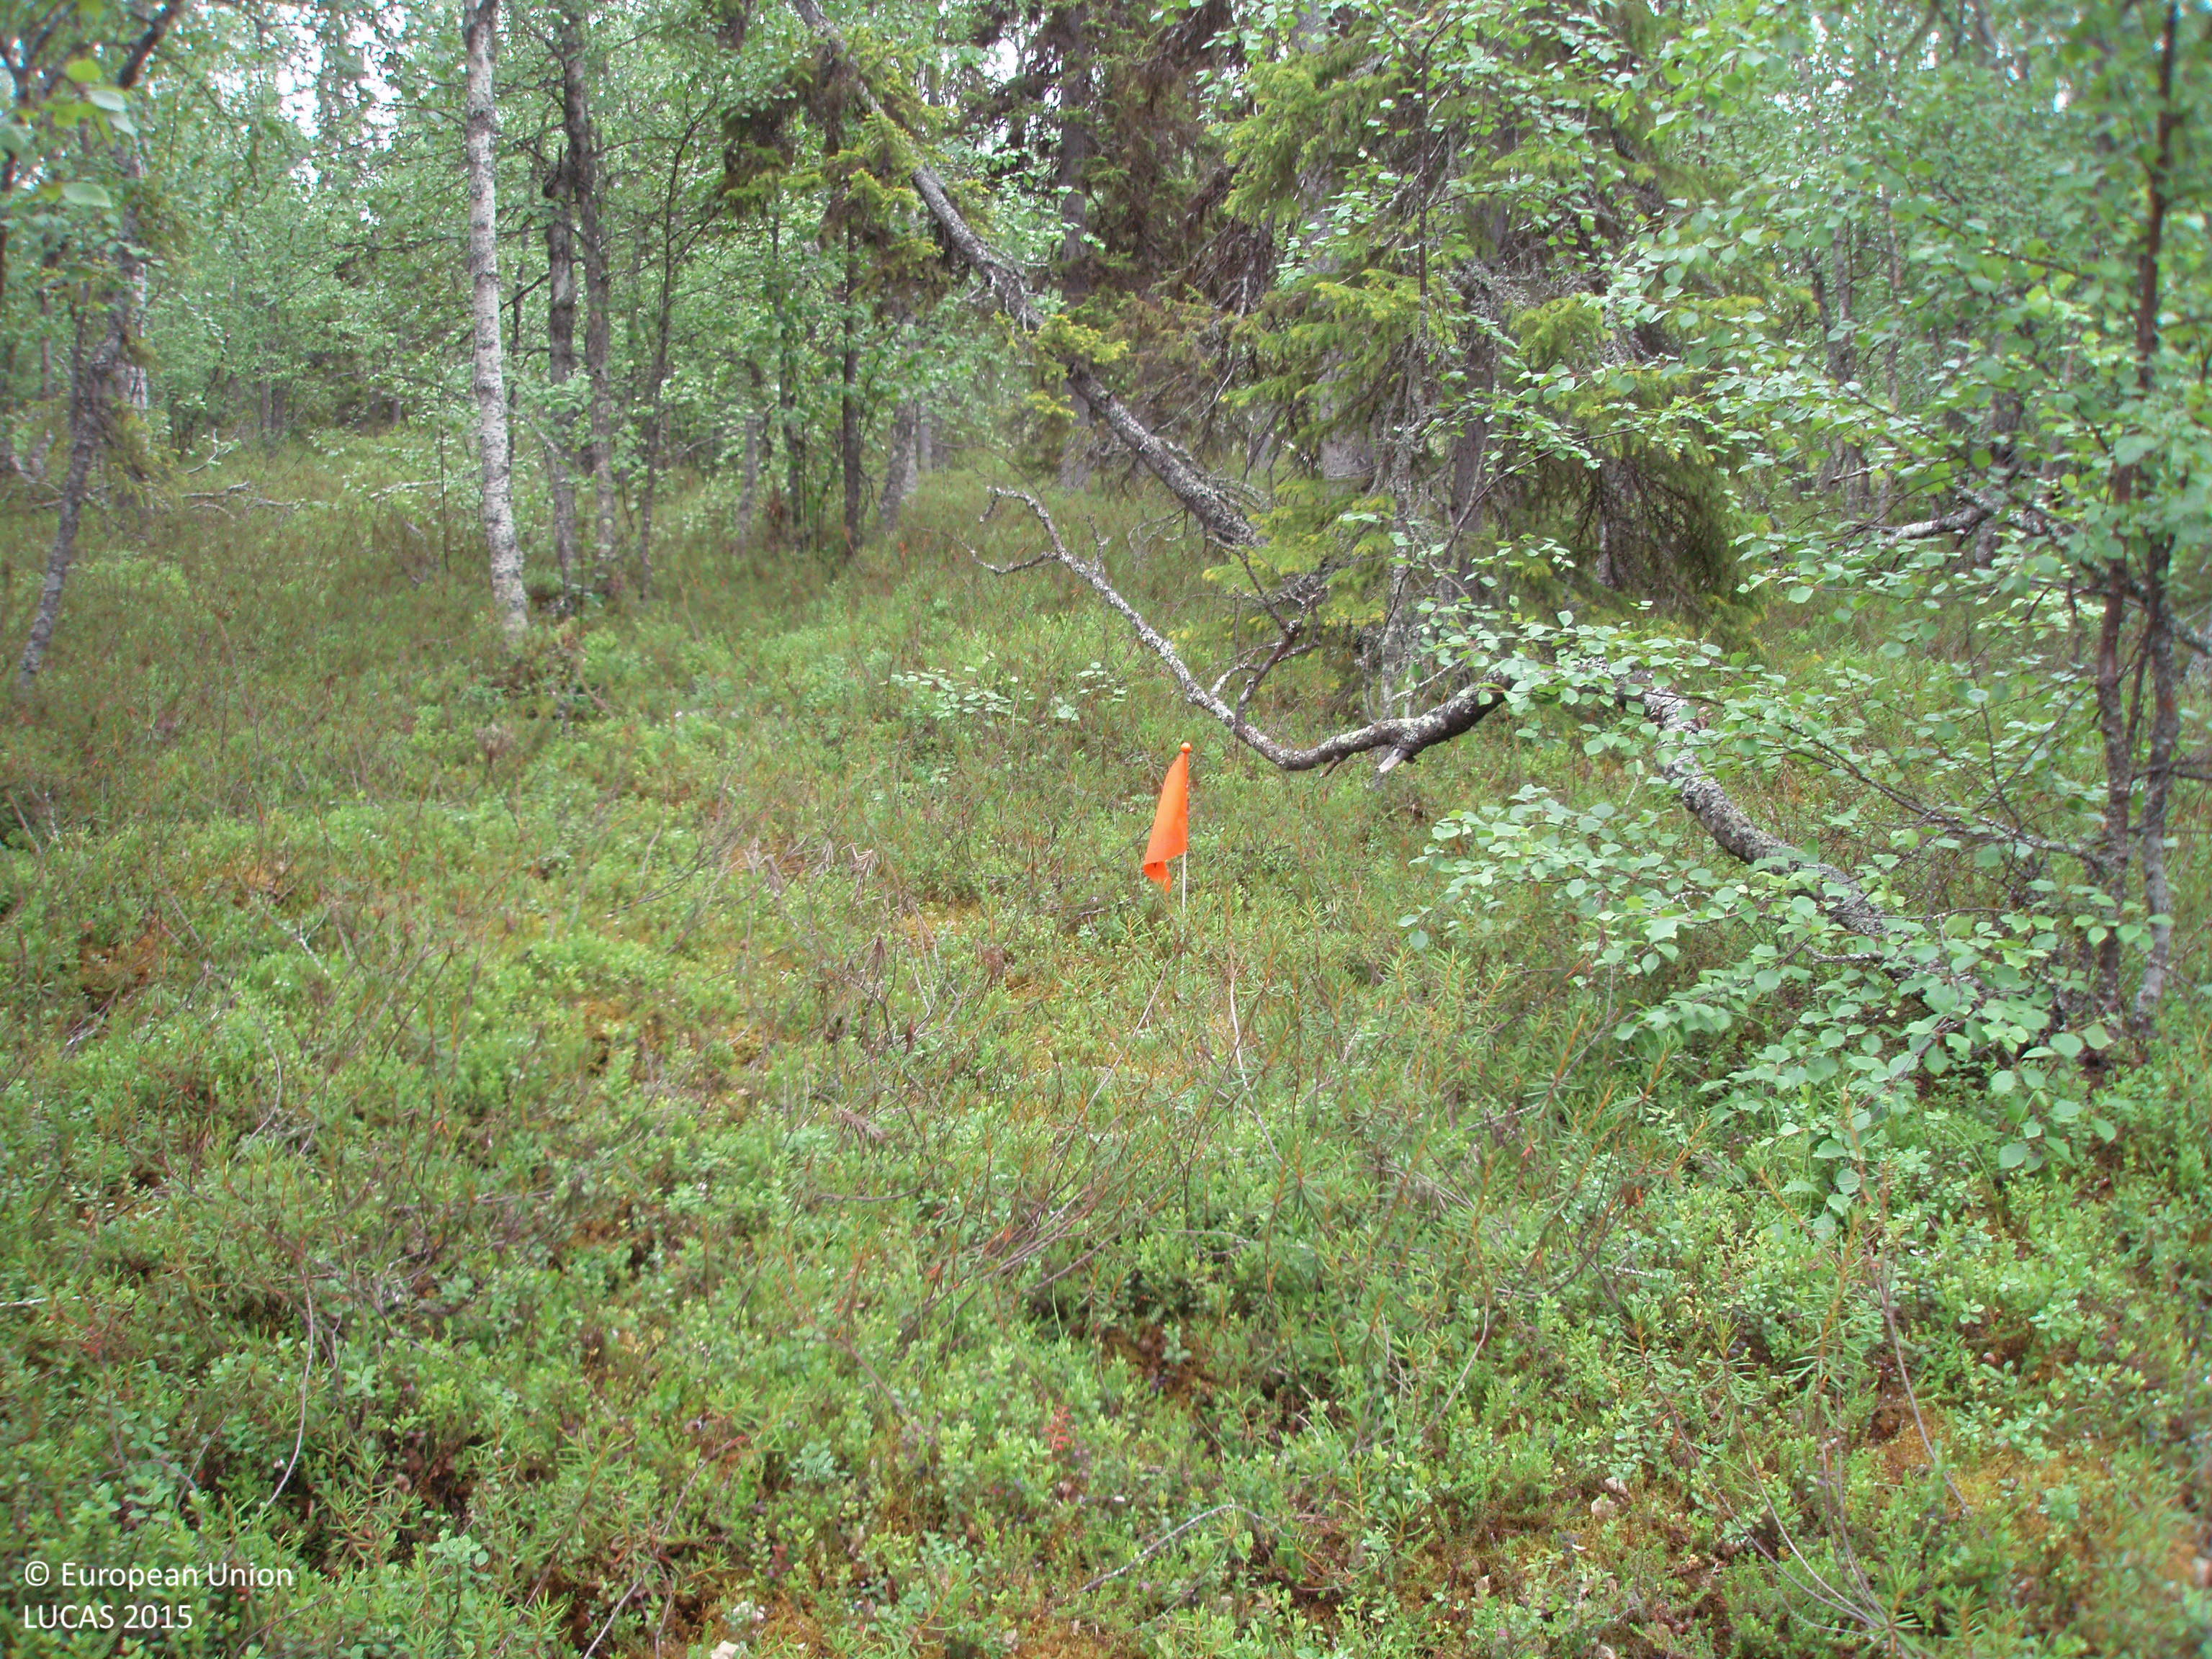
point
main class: Woodland
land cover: Spruce dominated mixed woodland
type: boreal forest
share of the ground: 50 - 75 %
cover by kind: coniferous forest trees 40 %, broadleaved forest trees 30 %, shrubs 30 %
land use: Forestry
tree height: > 5 m
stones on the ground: < 10 %
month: July
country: FI
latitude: 67.2381
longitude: 28.0215
